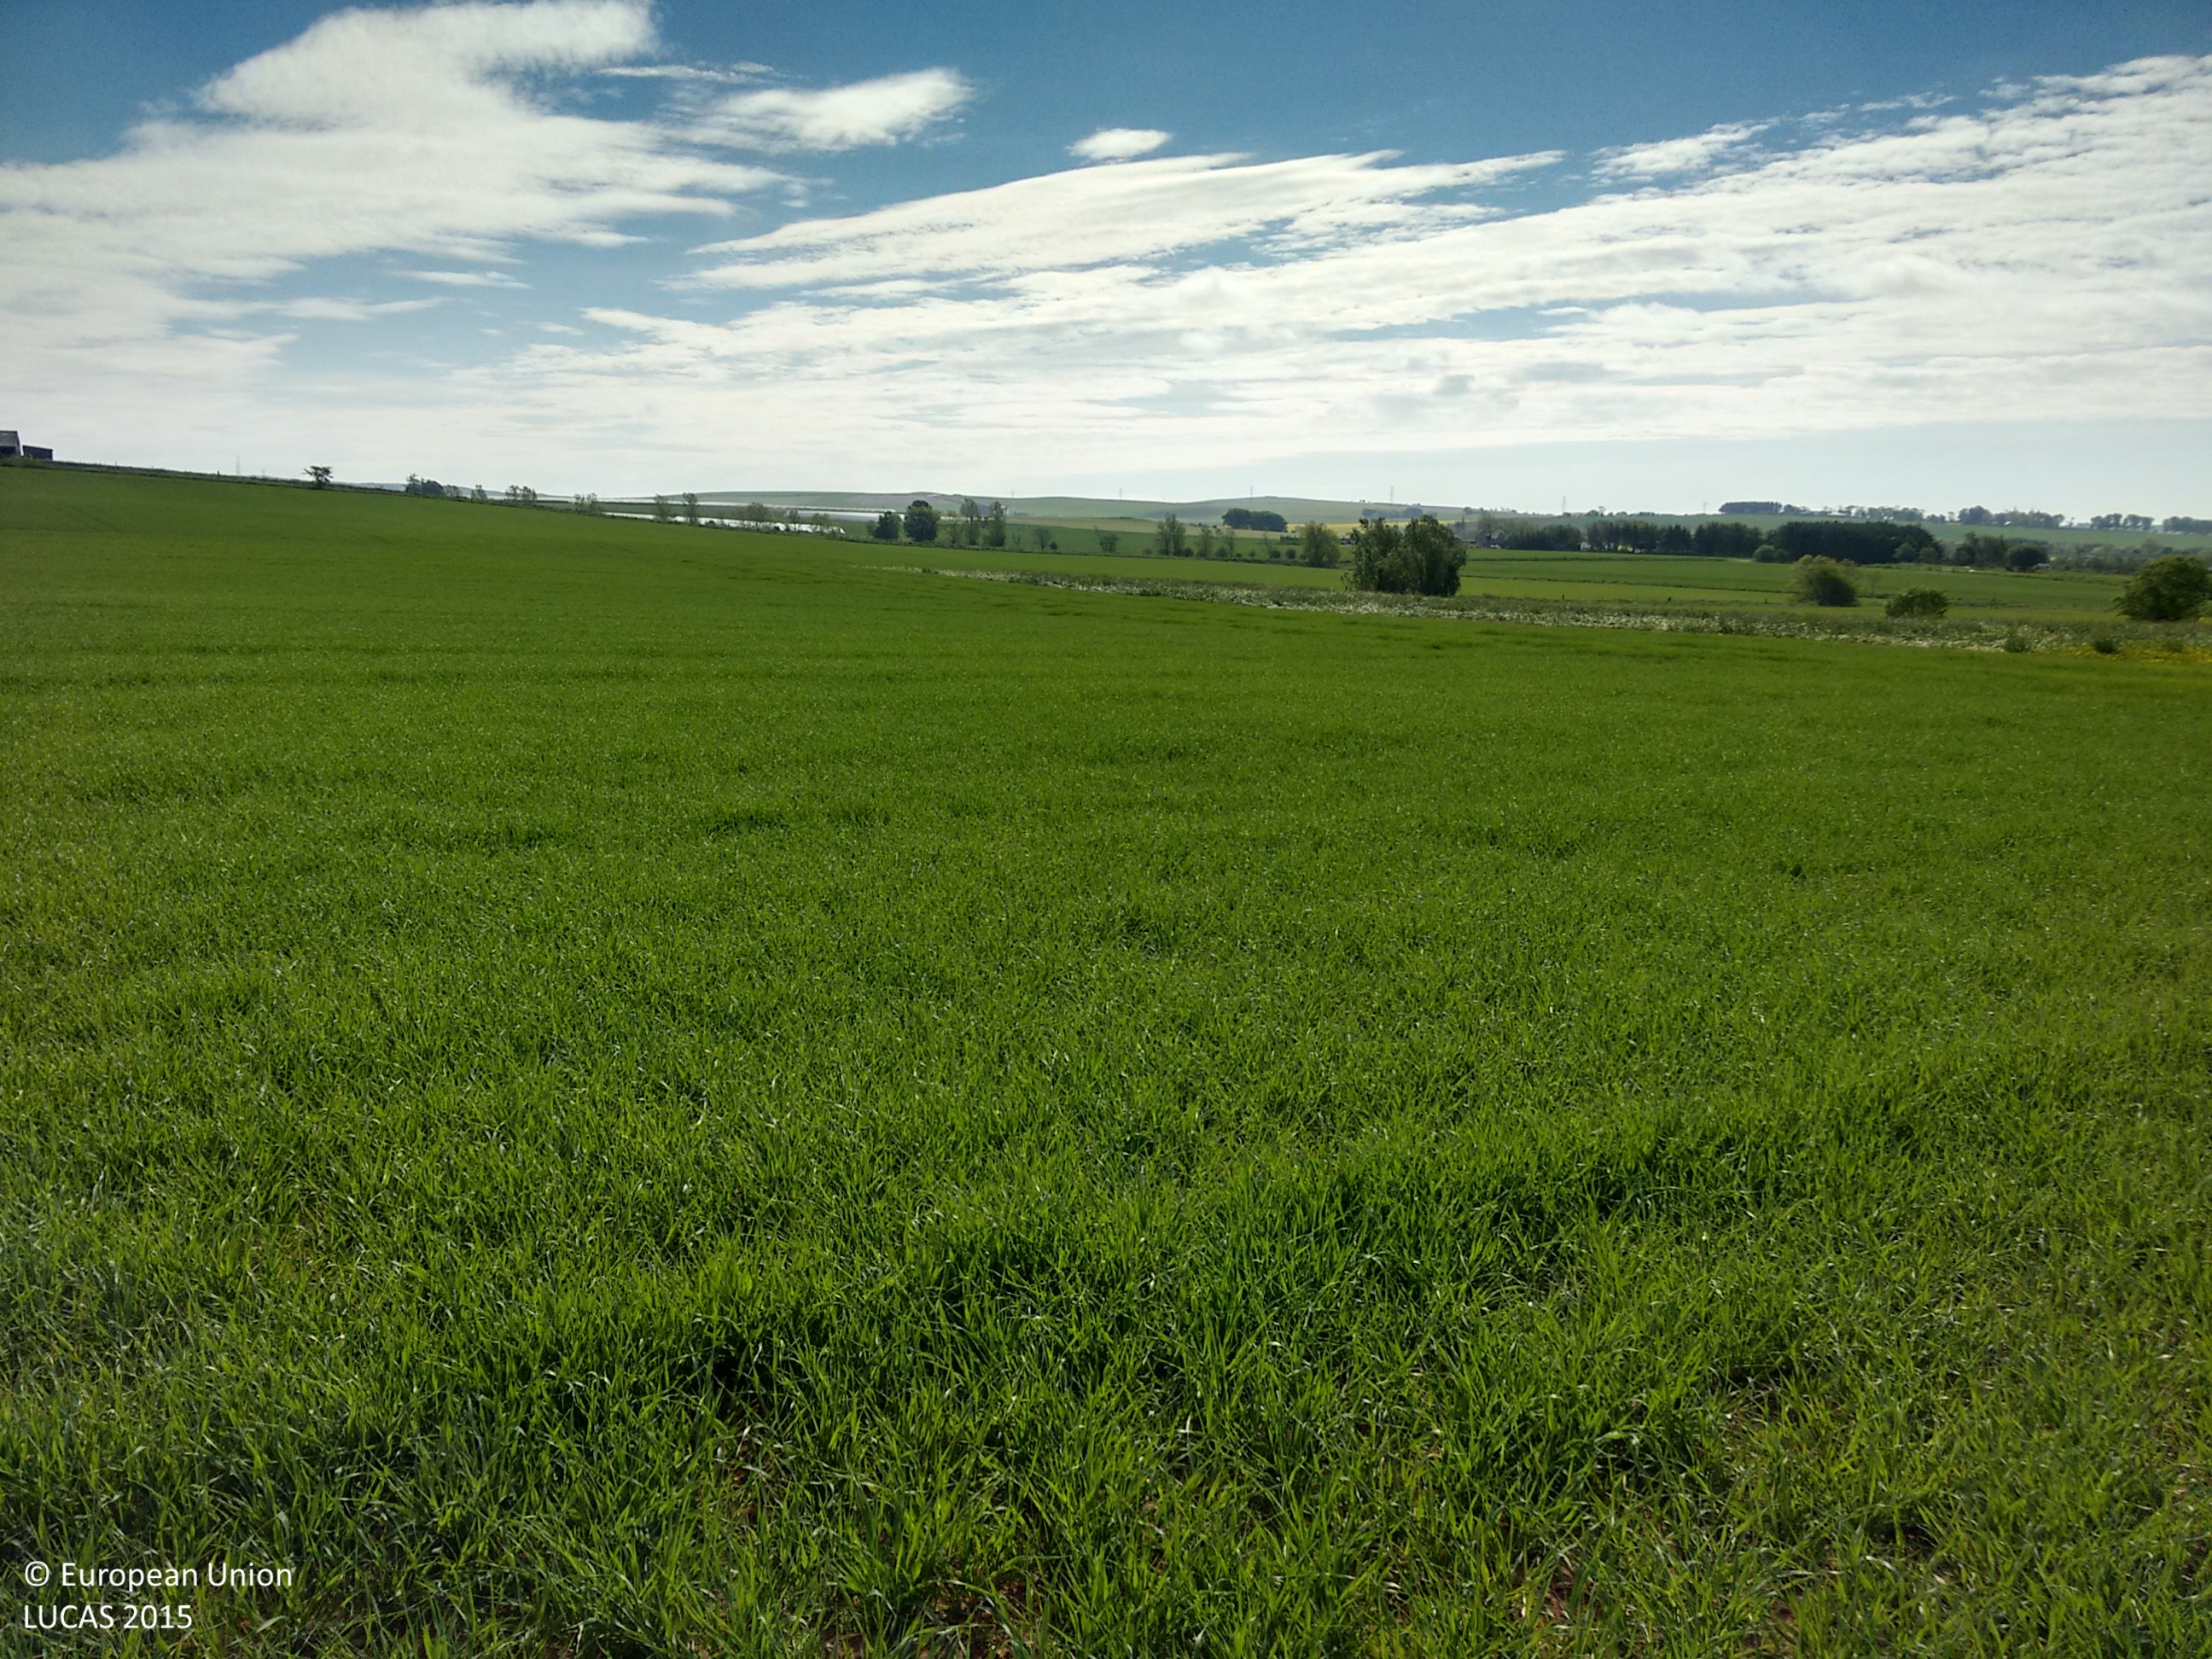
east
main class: Cropland
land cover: Barley
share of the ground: 25 - 50 %
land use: Agriculture (excluding fallow land and kitchen gardens)
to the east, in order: Barley; Floriculture and ornamental plants; Tracks; Grass margins; Fences; Ditches and canals; Spontaneously vegetated surfaces; Fences; Grass margins; Barley
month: June
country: GB
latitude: 56.8937
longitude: -2.4154
